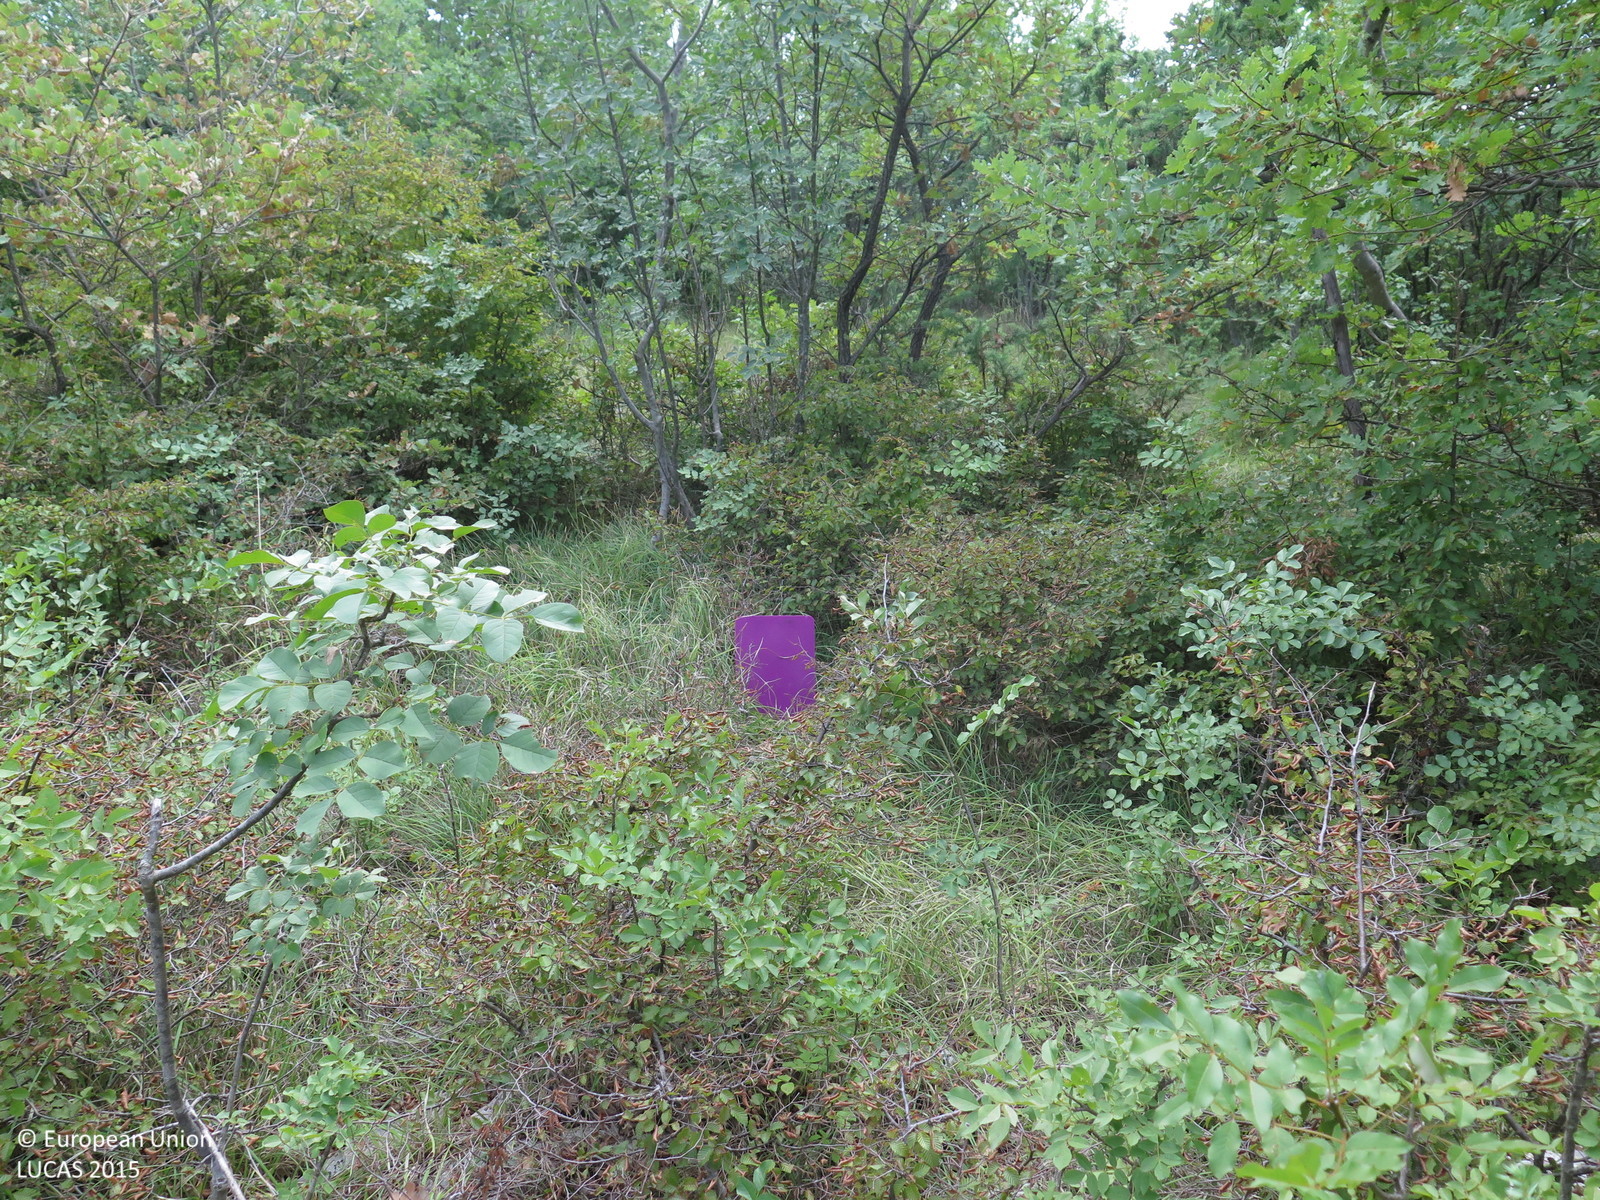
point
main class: Shrubland
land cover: Shrubland with sparse tree cover
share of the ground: > 75 %
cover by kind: shrubs 90 %, broadleaved forest trees 5 %, herbaceous plants 5 %
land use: Semi-natural and natural areas not in use
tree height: < 5 m
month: August
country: HR
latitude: 45.0463
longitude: 14.5268
